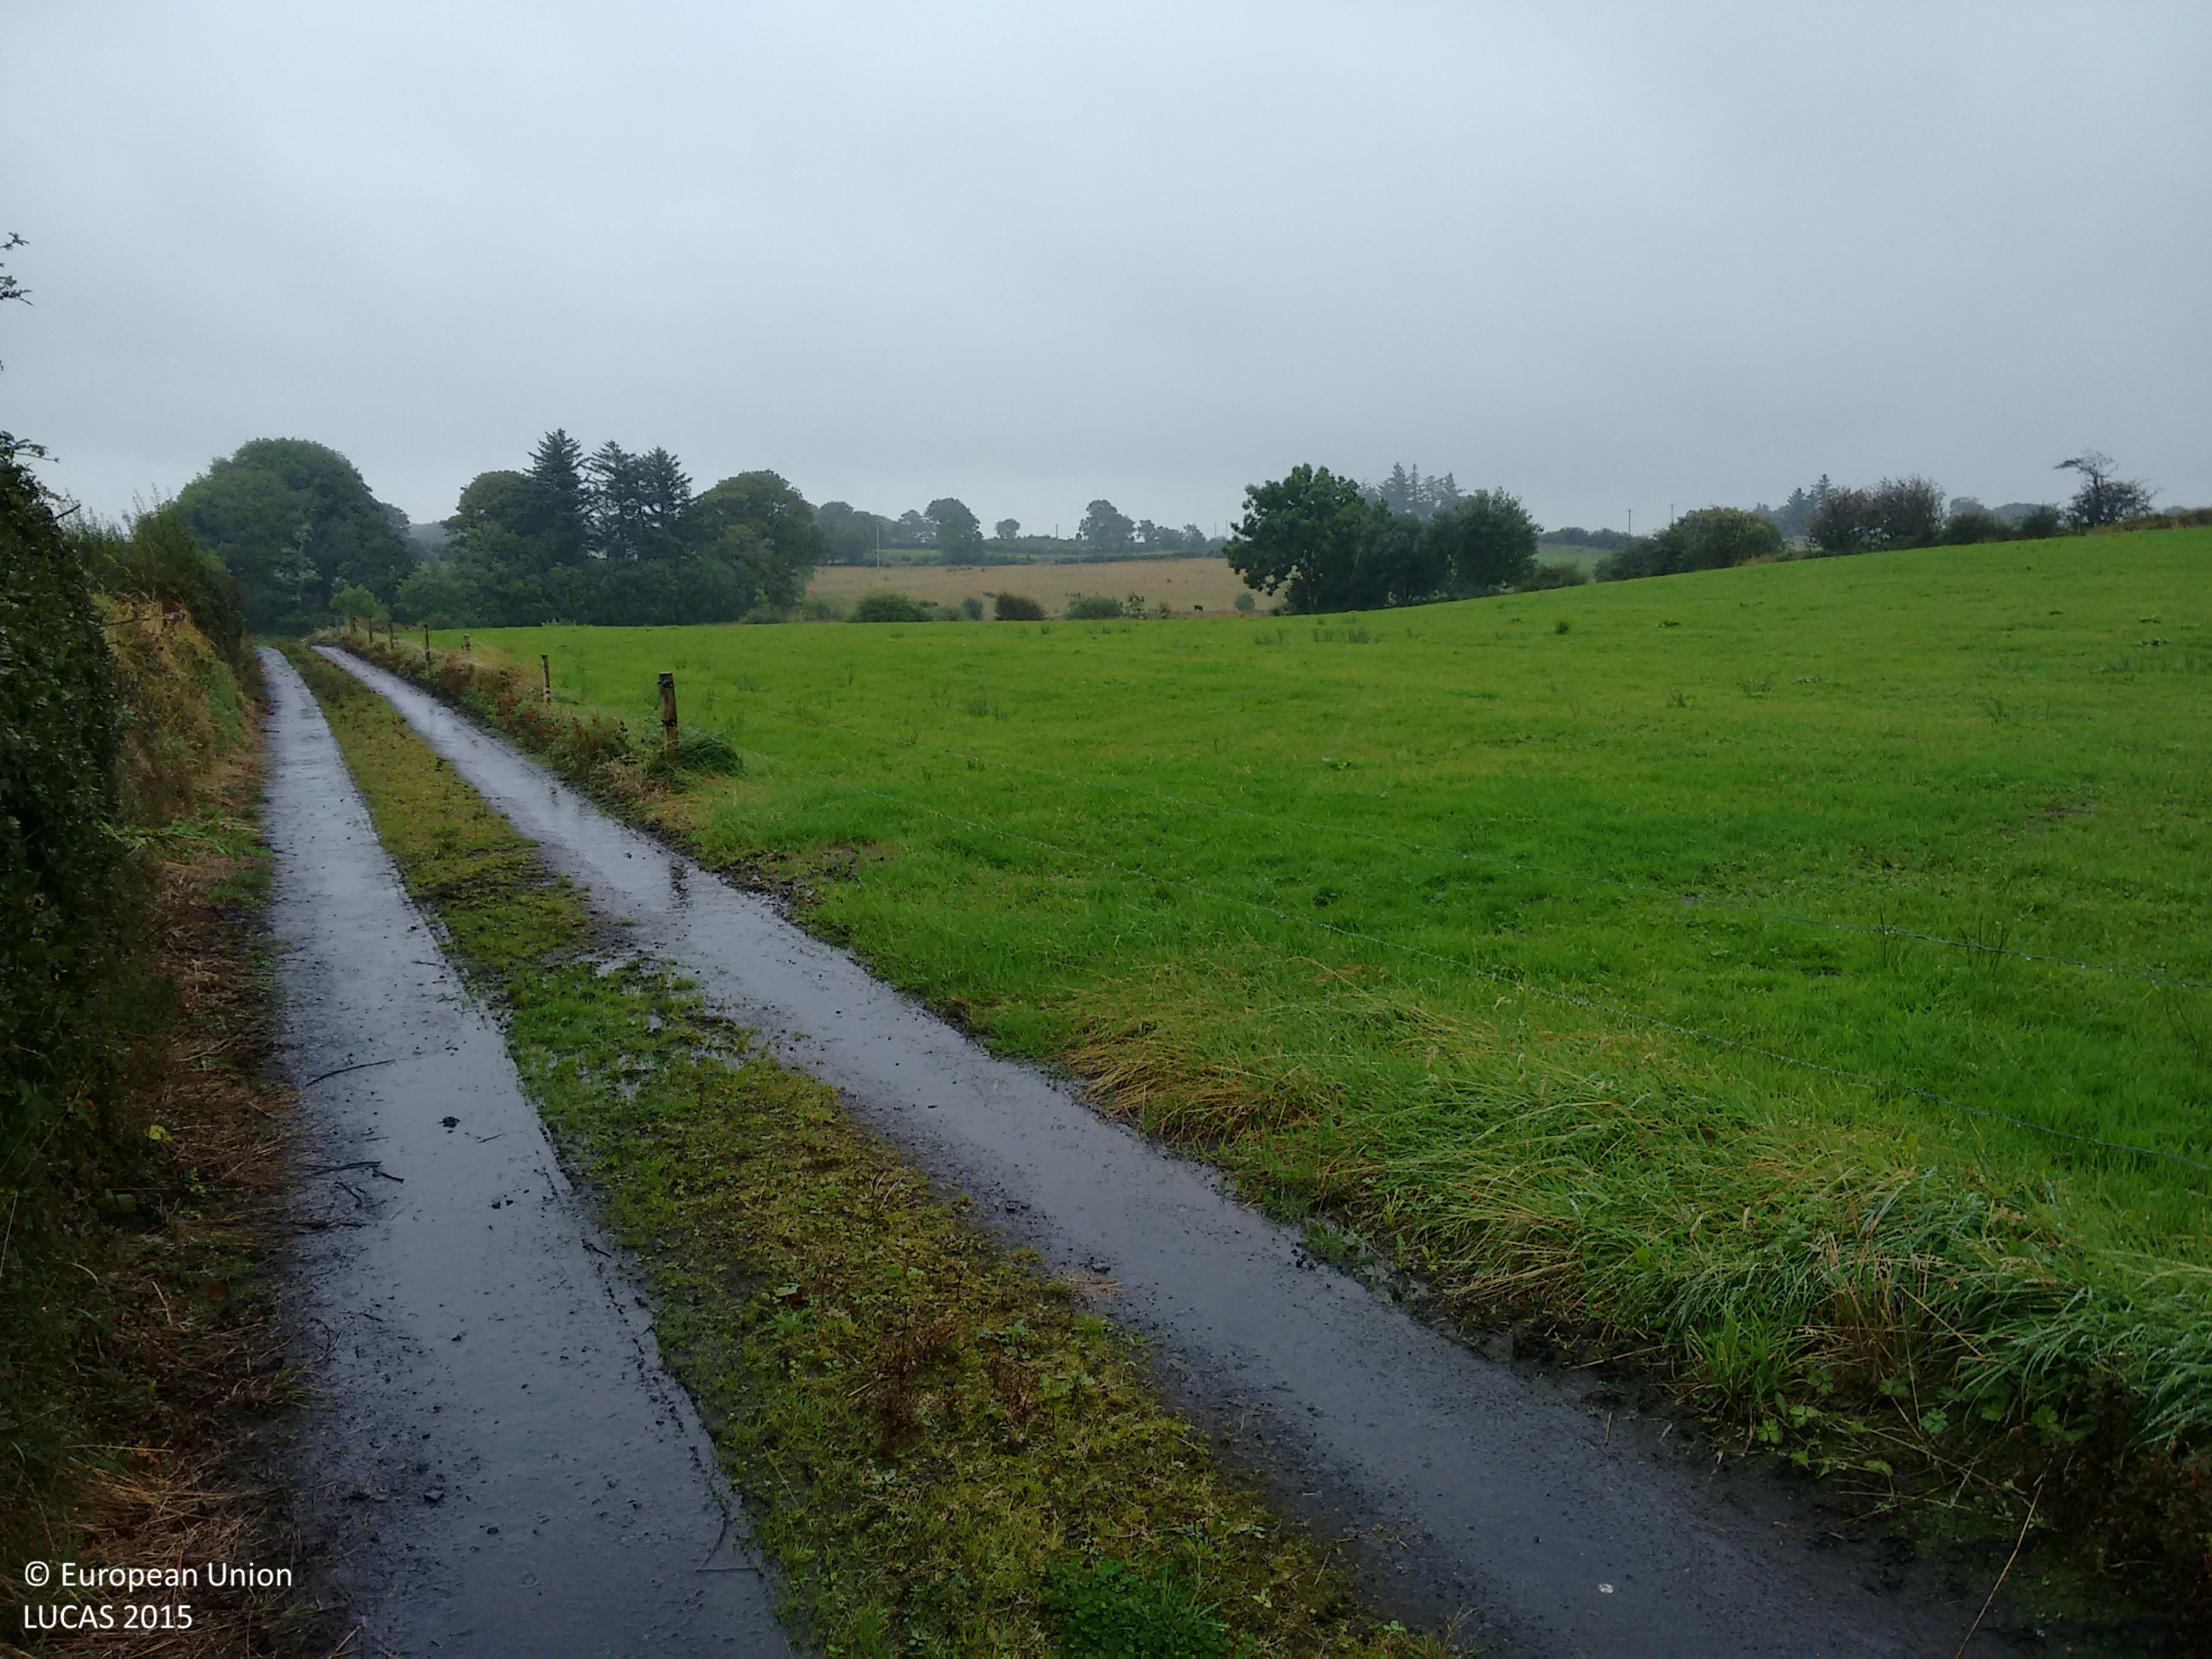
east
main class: Grassland
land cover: Grassland without tree/shrub cover
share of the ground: > 75 %
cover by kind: herbaceous plants 100 %
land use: Agriculture (excluding fallow land and kitchen gardens)
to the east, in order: Grassland without tree/shrub cover; Fences; Abandoned hedges; Fences; Abandoned hedges; Paved roads, cycling and walking lanes; Fences; Grassland without tree/shrub cover; Fences; Abandoned hedges; Fences; Grassland without tree/shrub cover
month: September
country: IE
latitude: 54.1489
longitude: -9.3798
